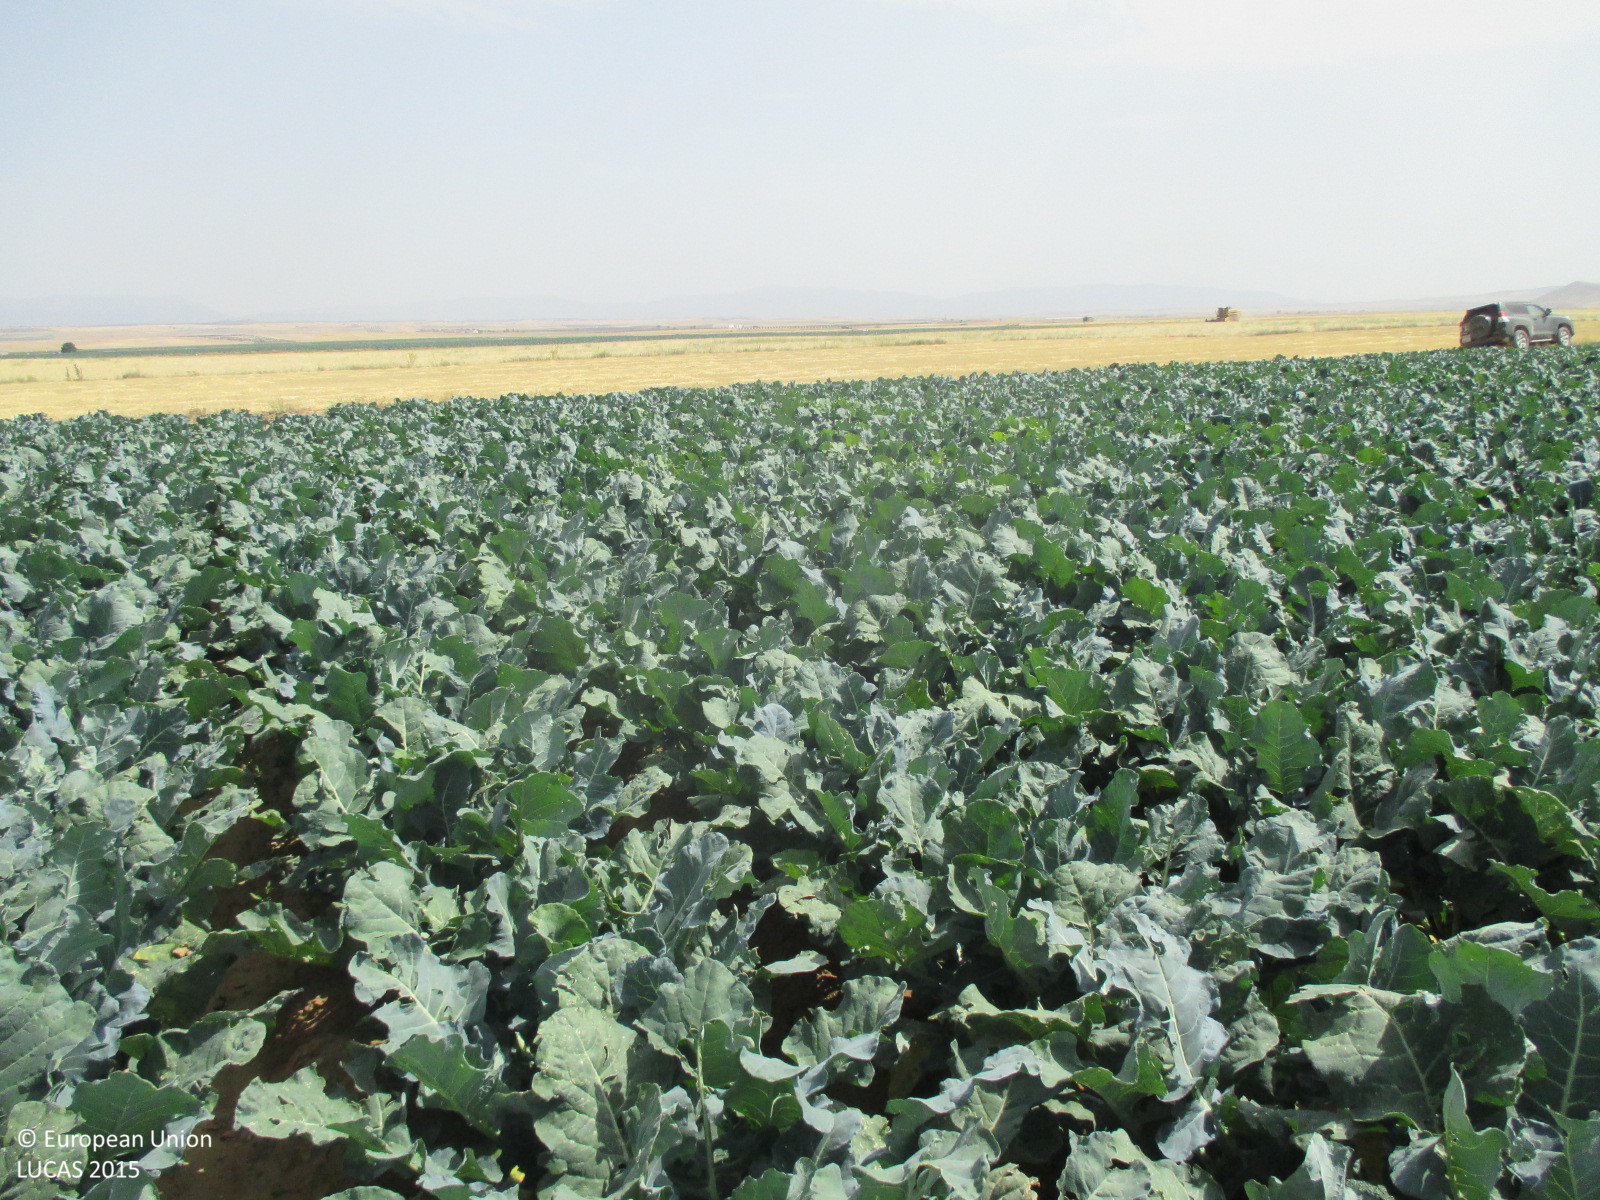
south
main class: Cropland
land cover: Other fresh vegetables
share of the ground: > 75 %
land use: Agriculture (excluding fallow land and kitchen gardens)
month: July
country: ES
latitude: 37.9039
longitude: -2.3982
